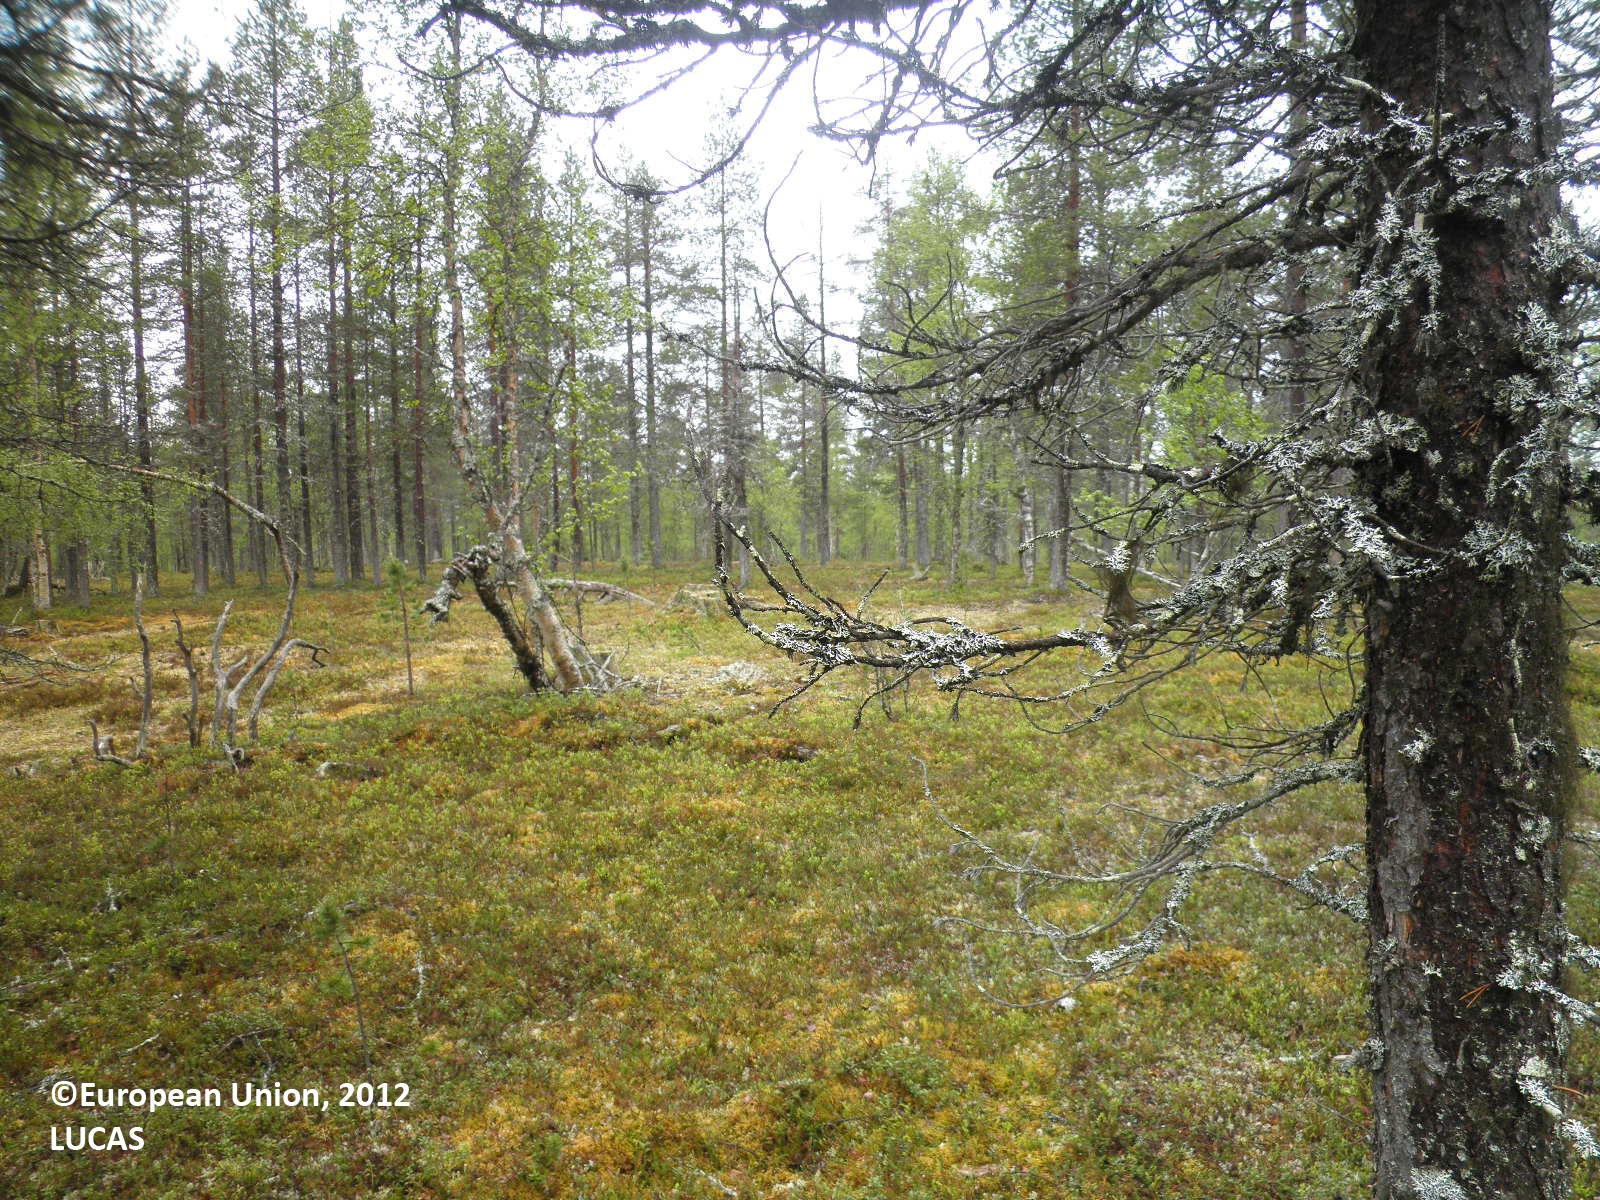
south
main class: Woodland
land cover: Pine dominated coniferous woodland
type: boreal forest
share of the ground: 25 - 50 %
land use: Forestry
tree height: > 5 m
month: June
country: FI
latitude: 68.1420
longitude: 25.6135
